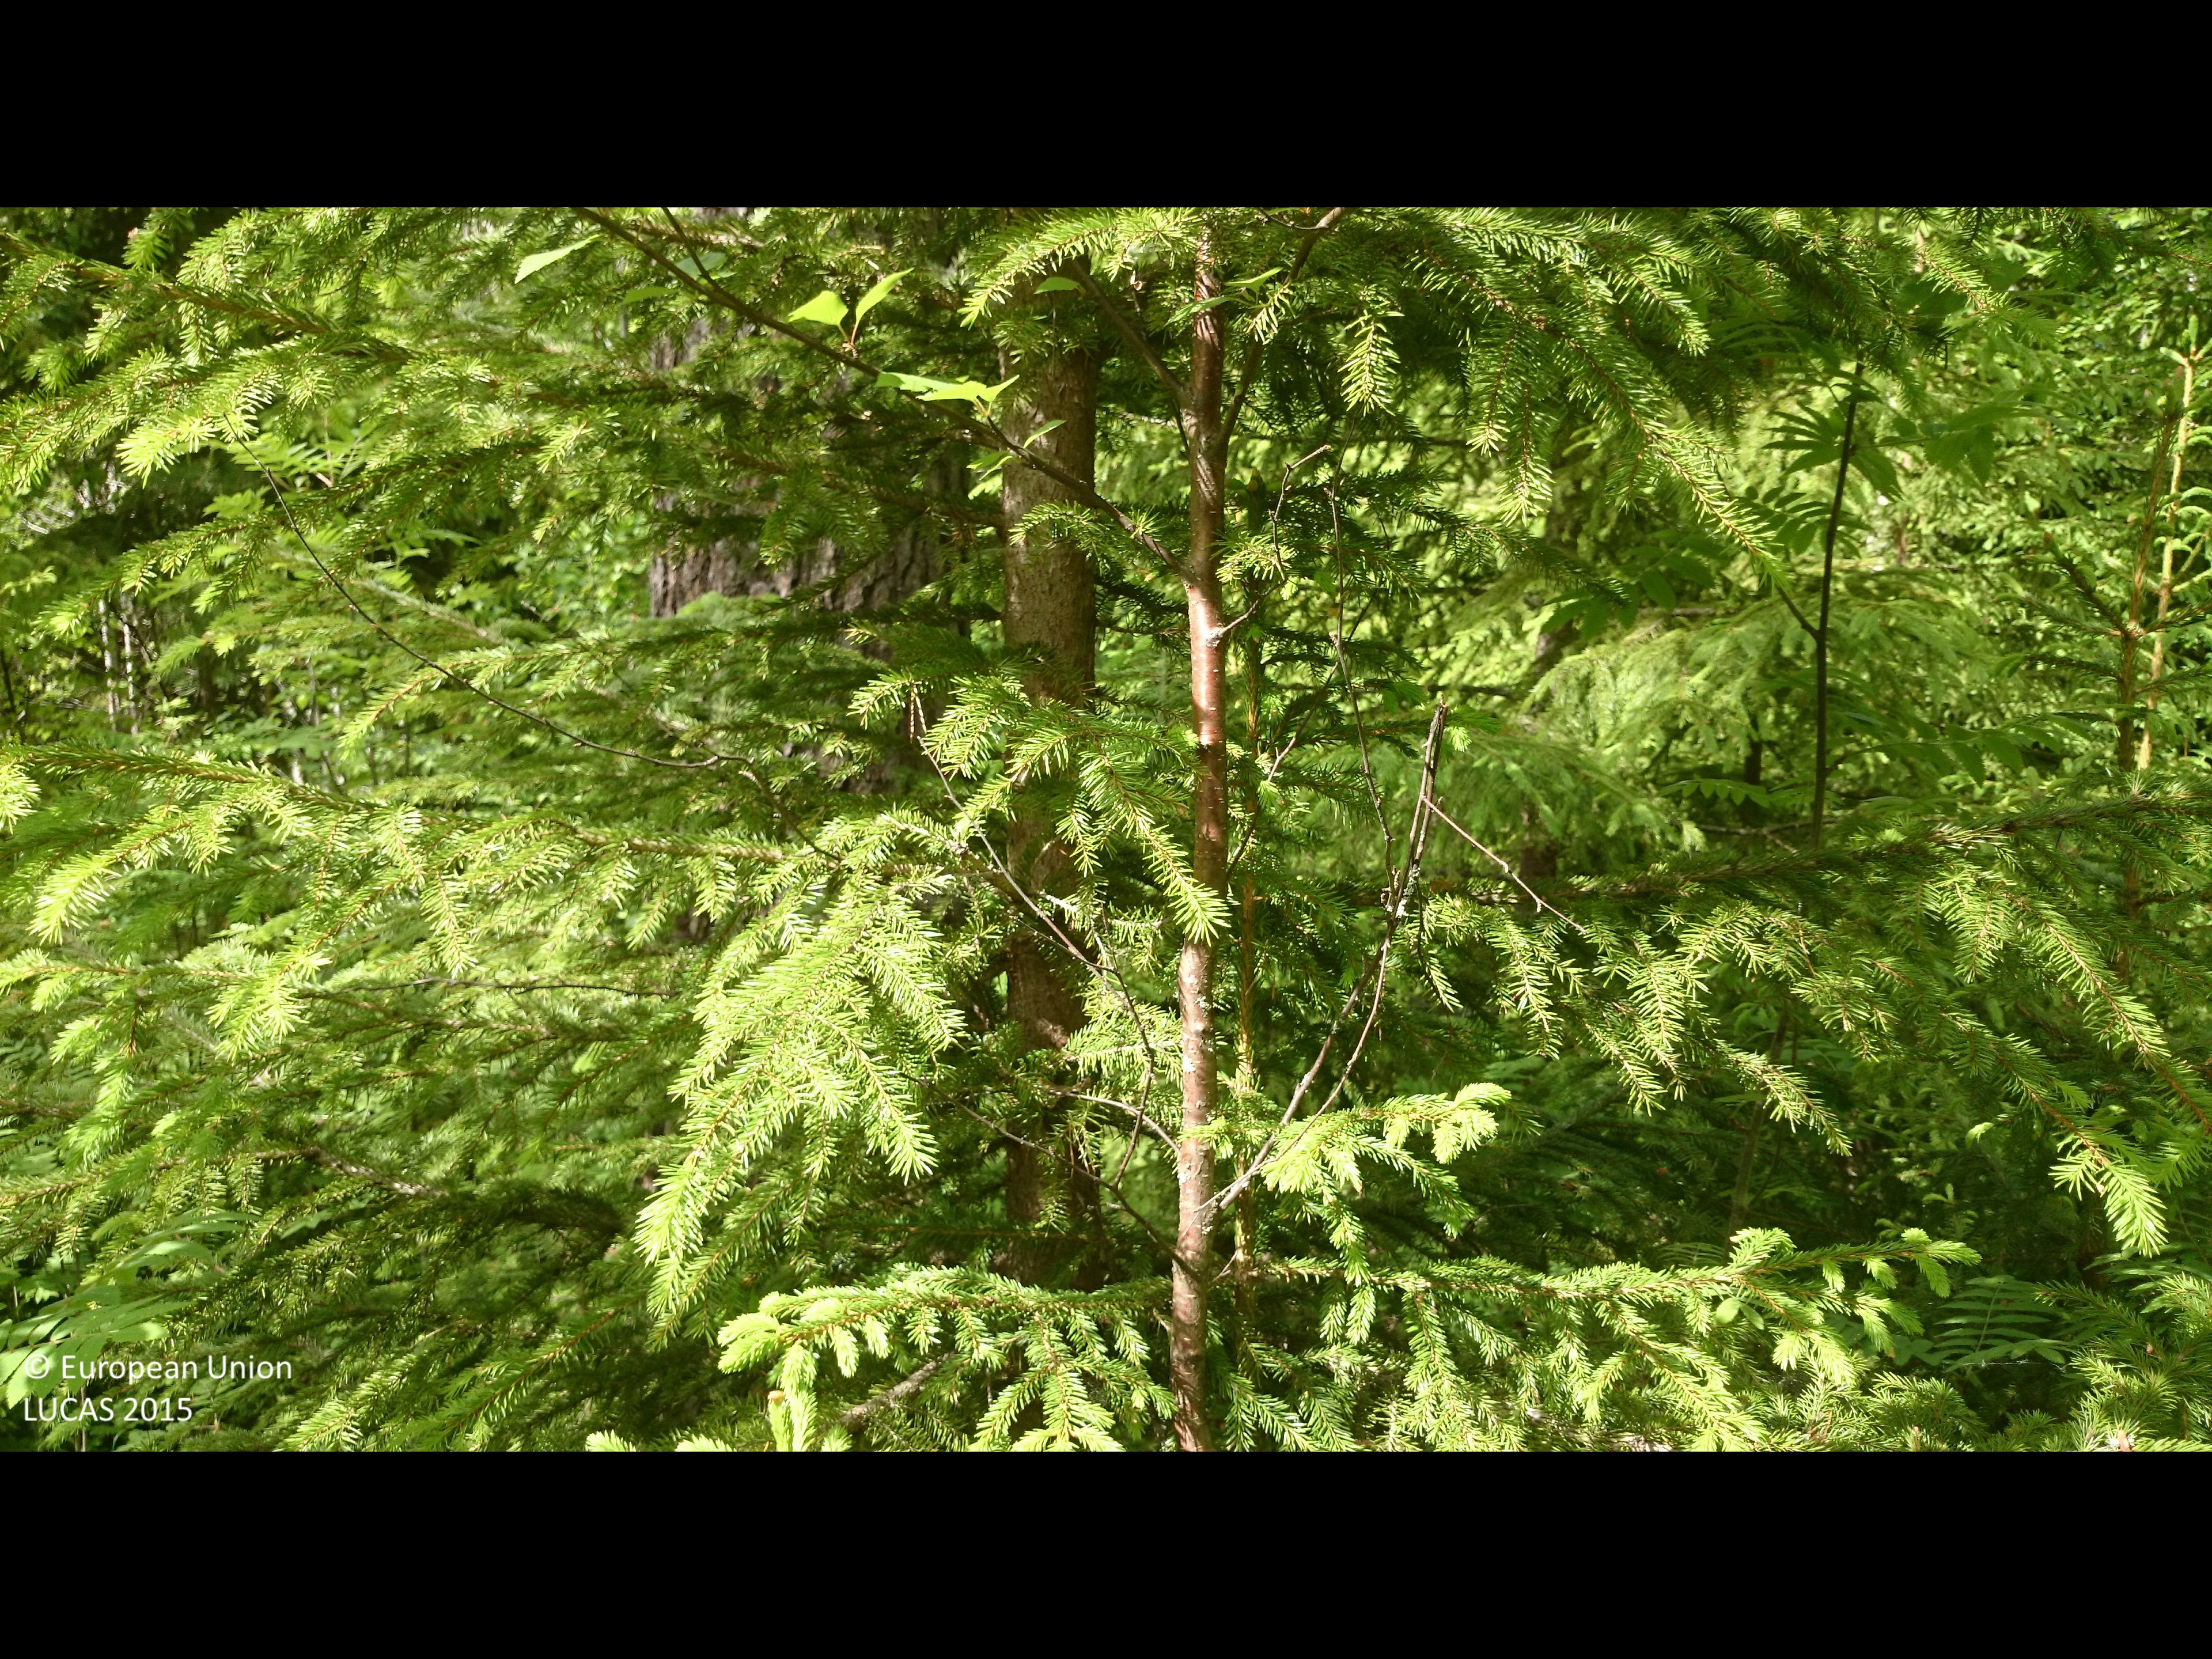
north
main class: Woodland
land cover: Other mixed woodland
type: boreal forest
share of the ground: 50 - 75 %
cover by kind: broadleaved forest trees 35 %, coniferous forest trees 30 %, herbaceous plants 20 %, lichens and mosses 15 %
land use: Forestry
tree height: > 5 m
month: June
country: SE
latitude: 62.0813
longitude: 16.7396
